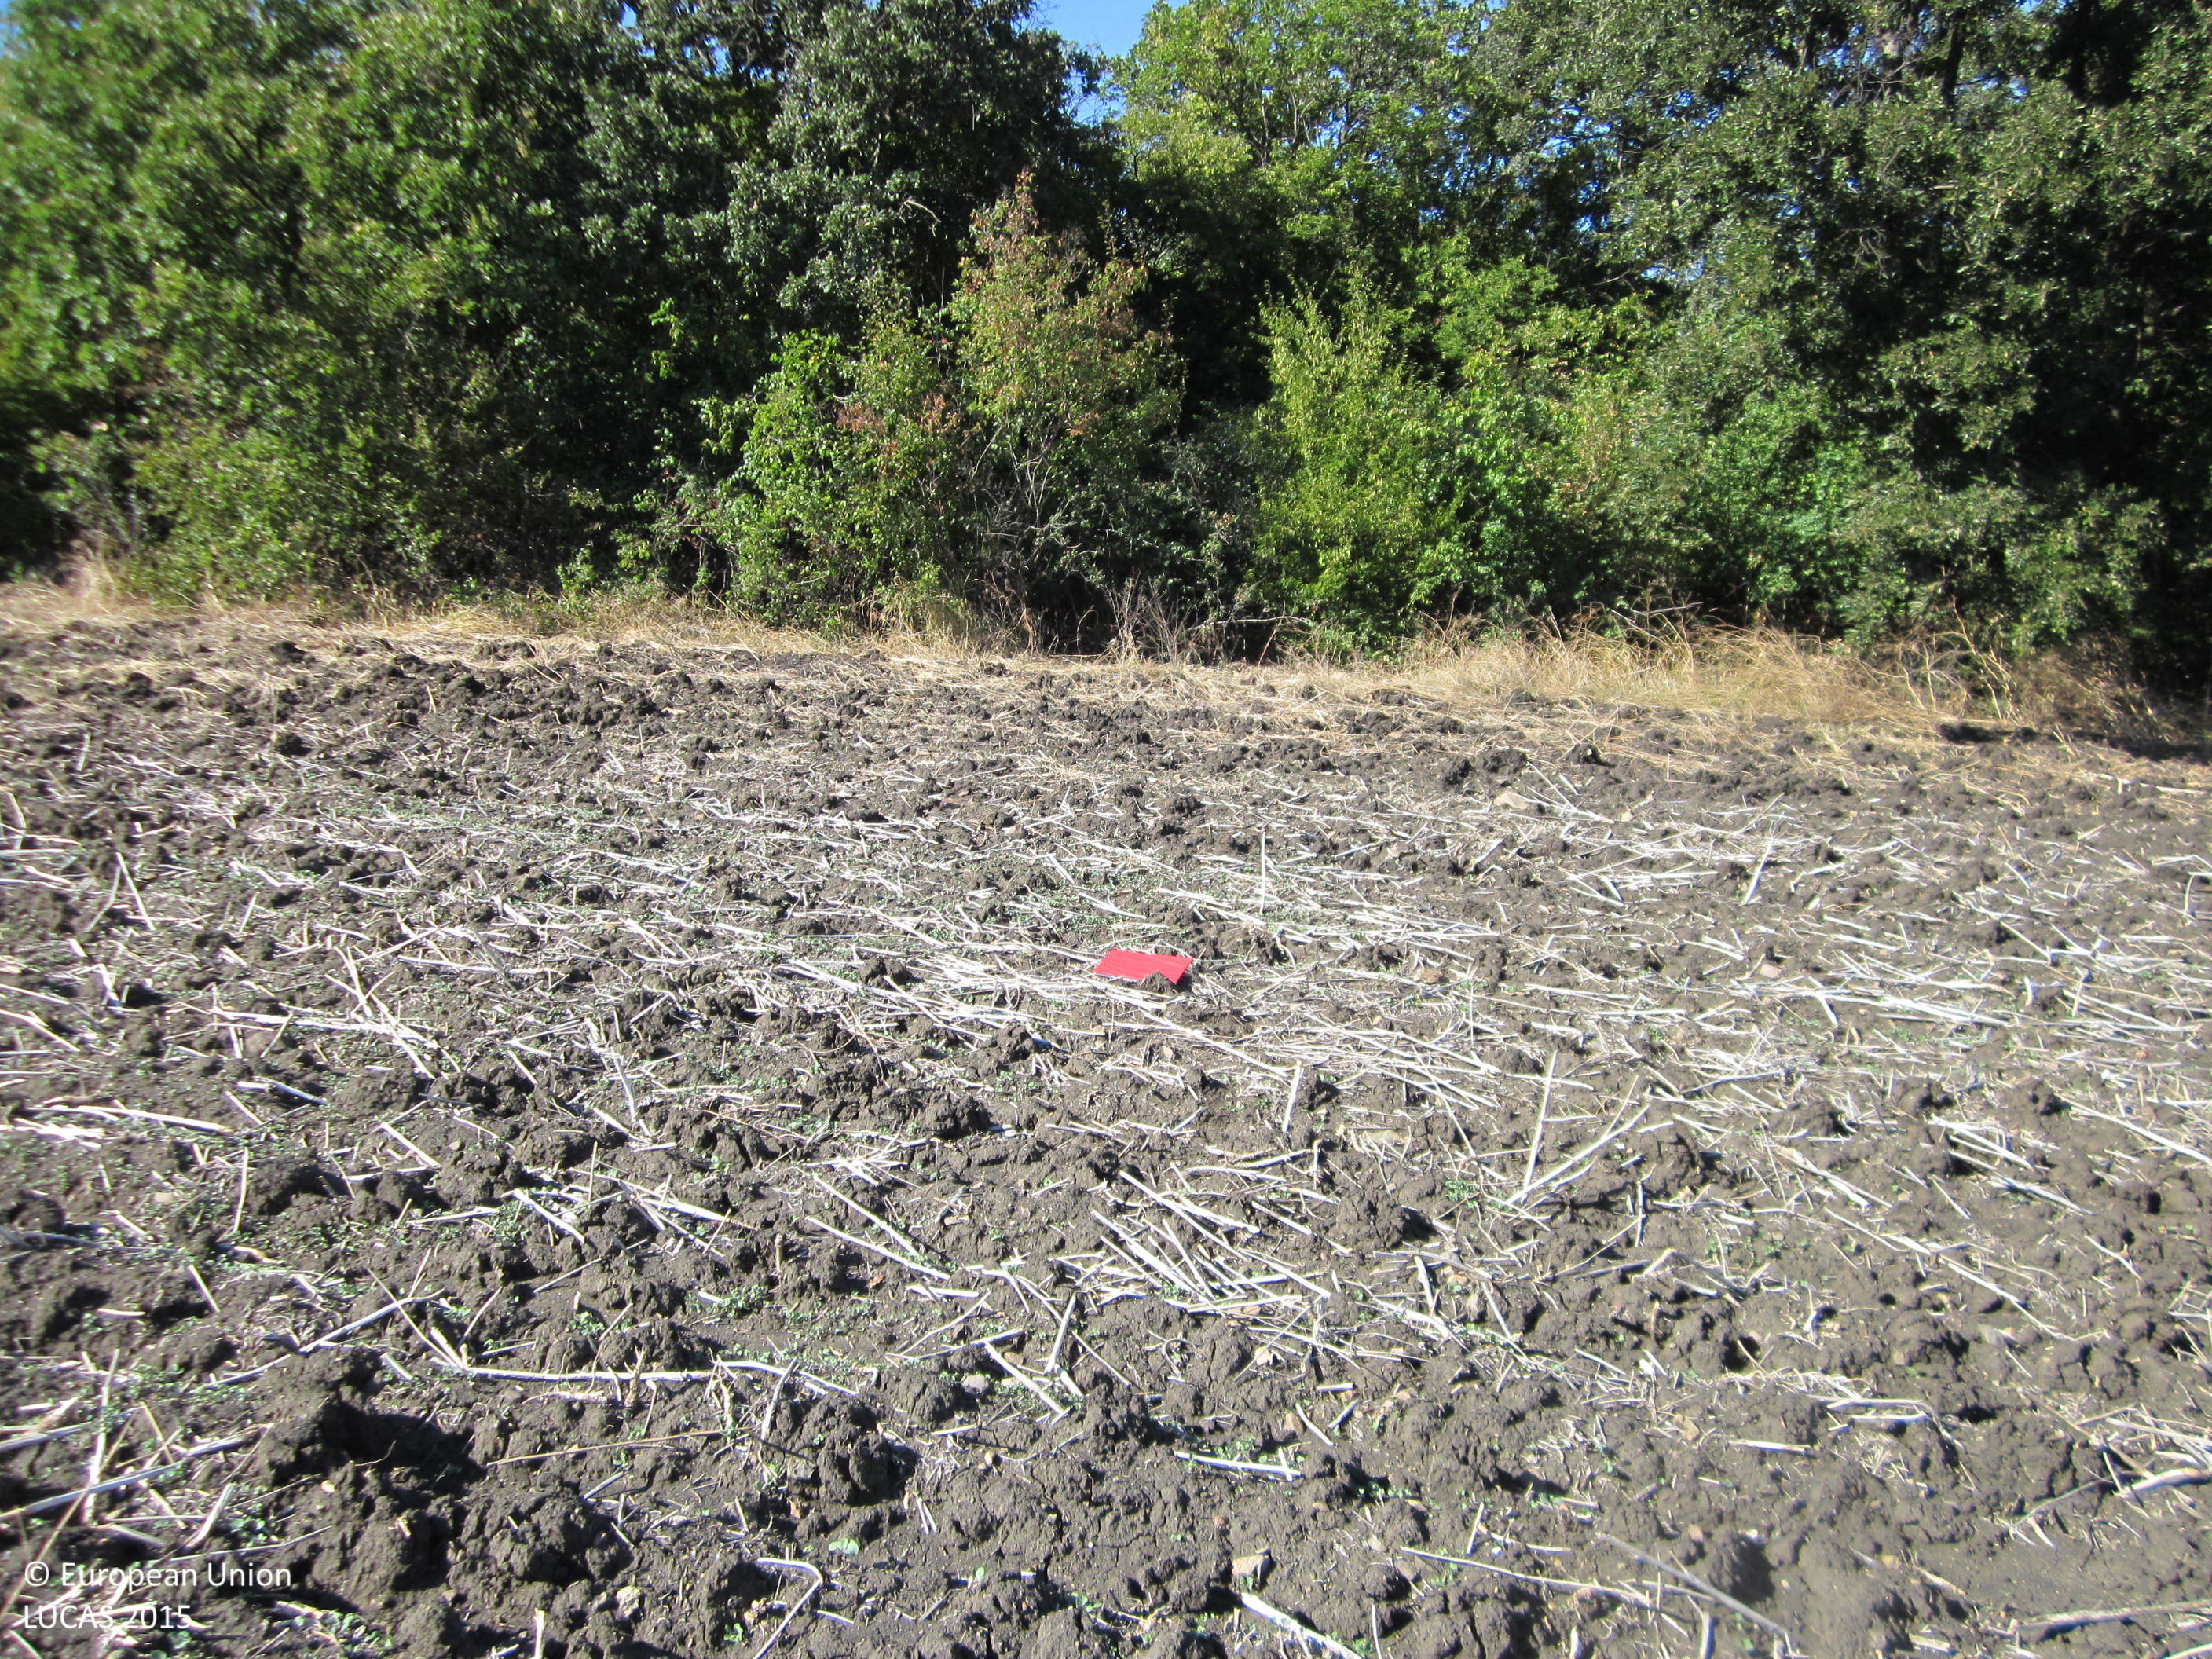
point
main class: Cropland
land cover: Sunflower
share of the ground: < 10 %
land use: Agriculture (excluding fallow land and kitchen gardens)
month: September
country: BG
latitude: 42.5020
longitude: 27.0574
